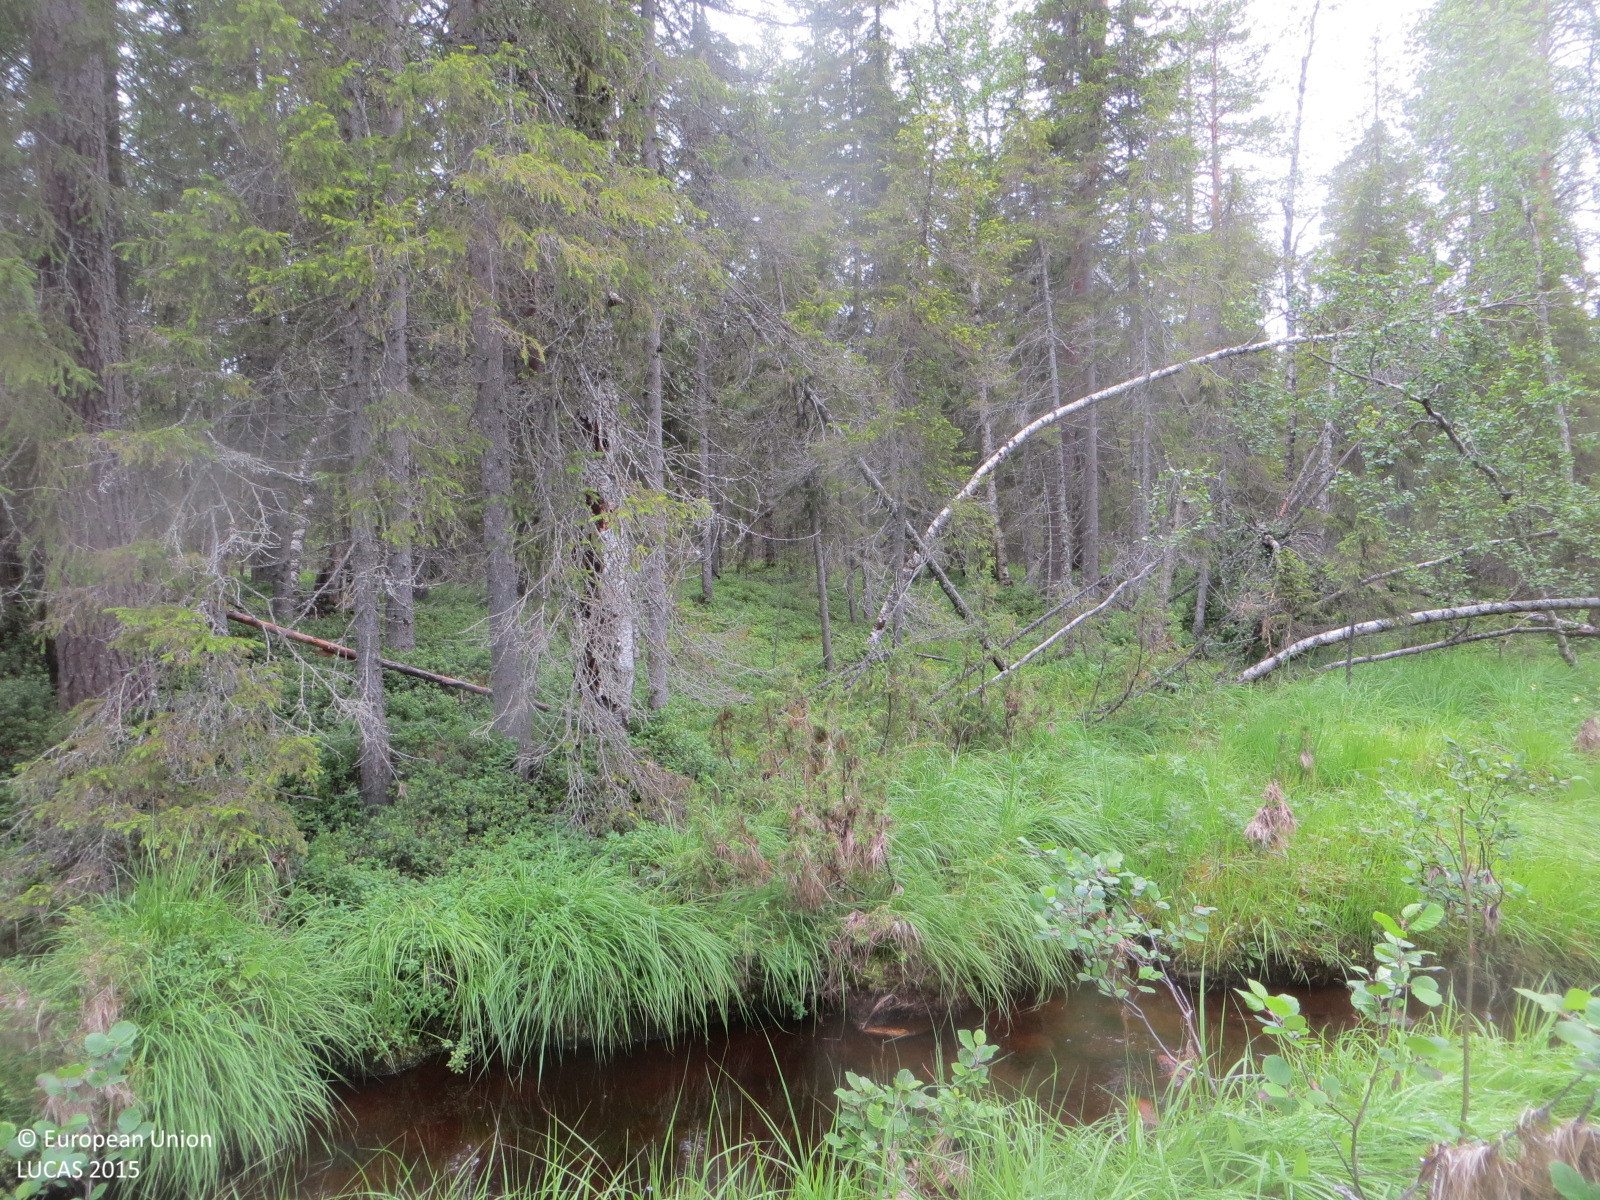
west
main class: Woodland
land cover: Other mixed woodland
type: boreal forest
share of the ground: 50 - 75 %
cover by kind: herbaceous plants 45 %, coniferous forest trees 30 %, broadleaved forest trees 25 %
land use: Semi-natural and natural areas not in use
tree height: > 5 m
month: July
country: FI
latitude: 66.2999
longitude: 24.8352
